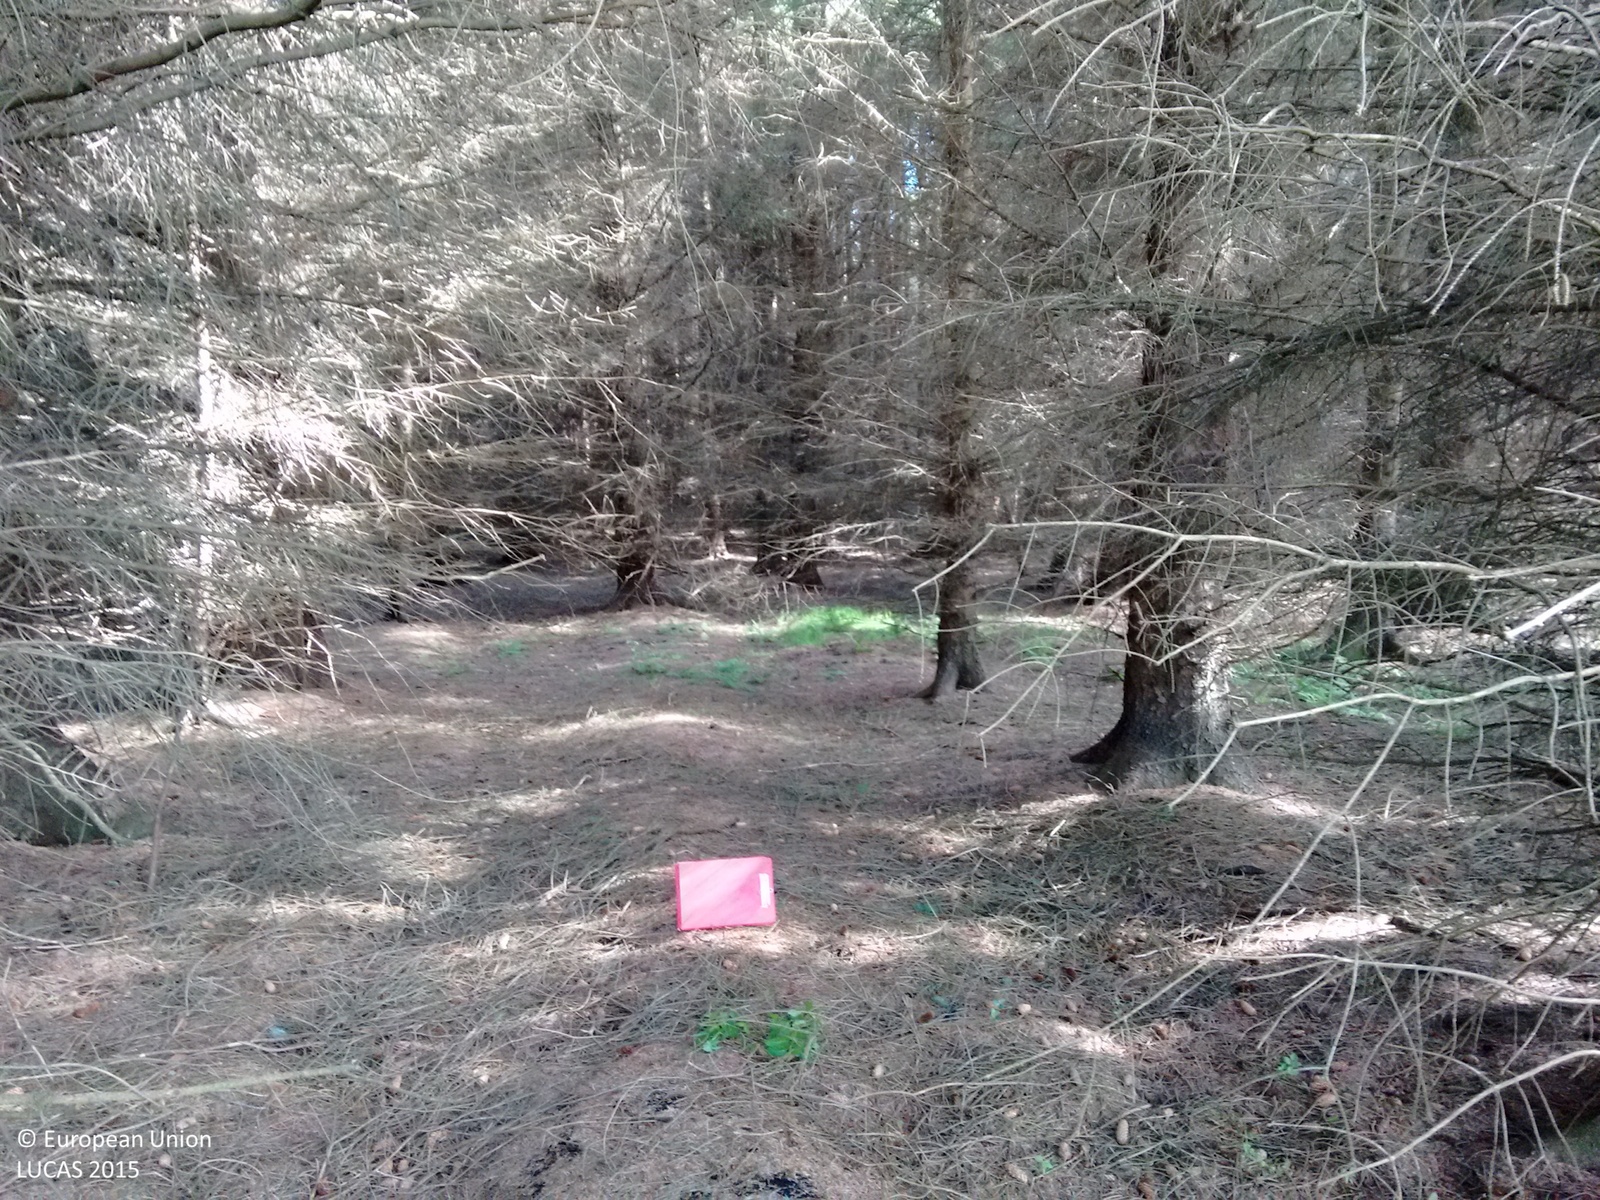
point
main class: Woodland
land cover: Spruce dominated coniferous woodland
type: exotic forest
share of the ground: > 75 %
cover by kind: coniferous forest trees 100 %
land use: Forestry
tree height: > 5 m
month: July
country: GB
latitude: 54.9257
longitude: -4.4408
